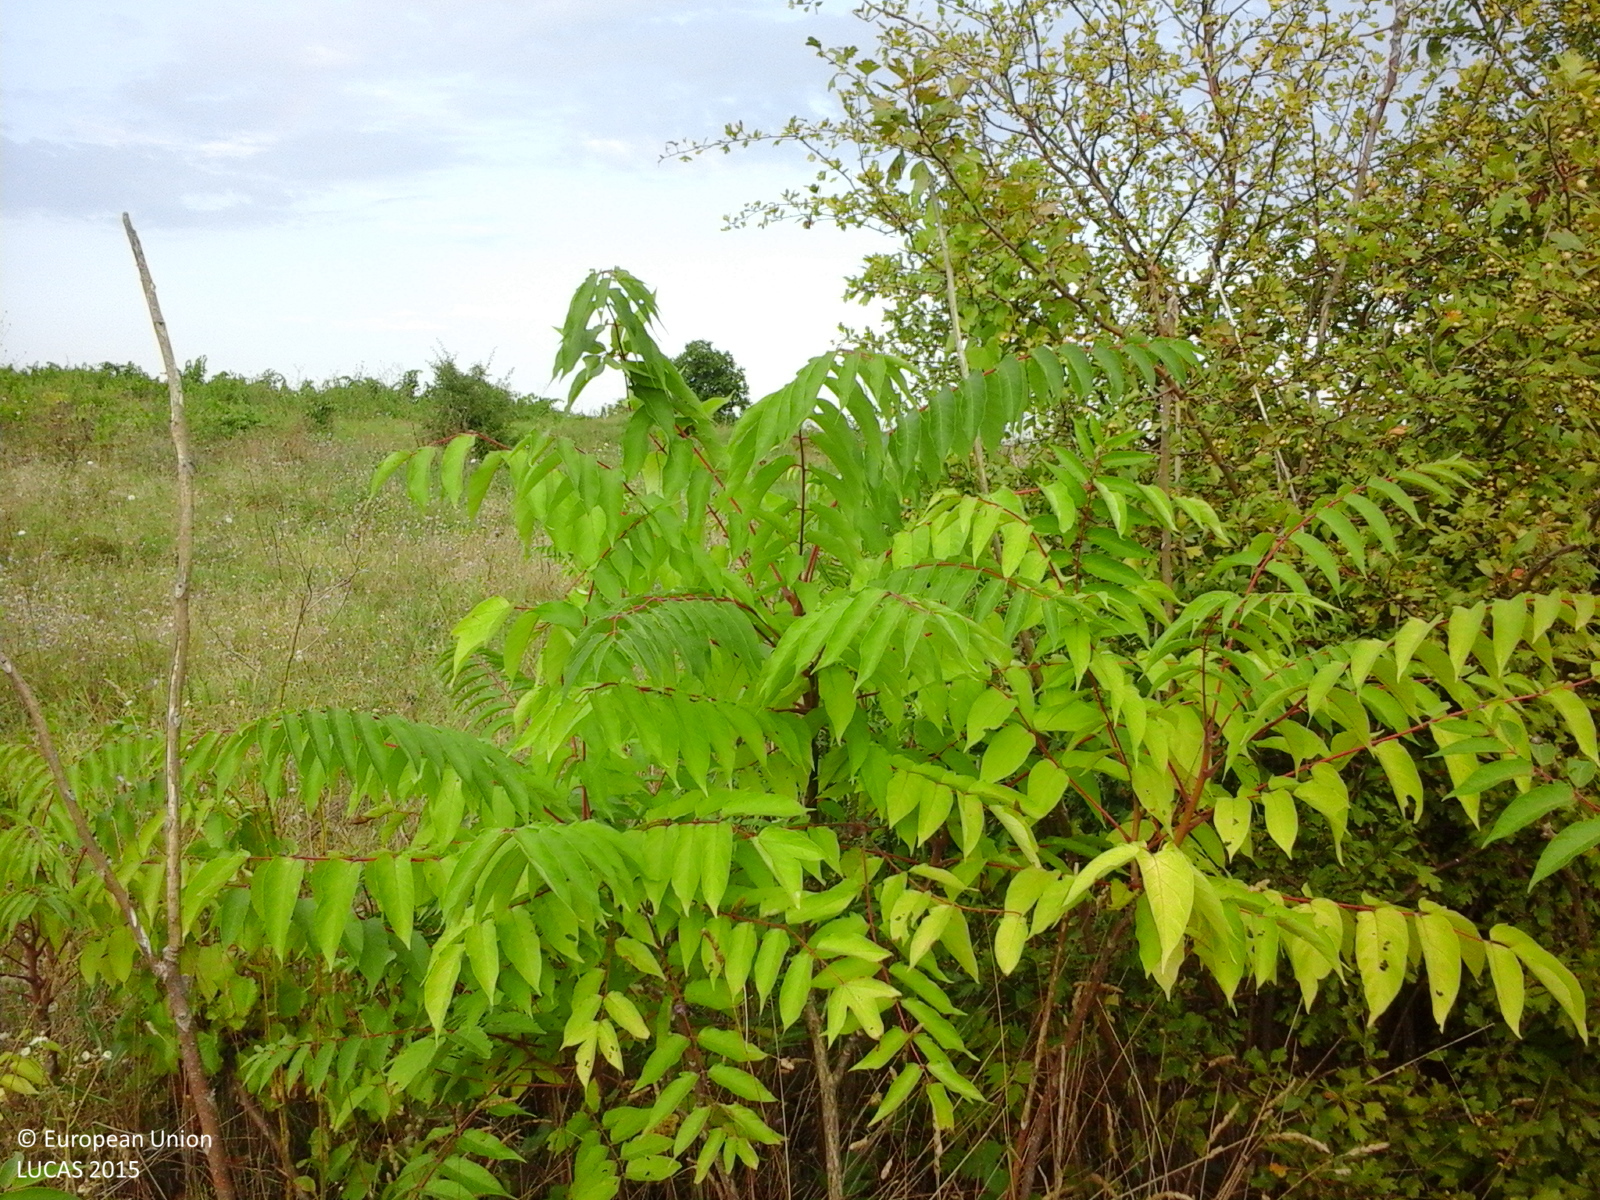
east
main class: Shrubland
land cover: Shrubland with sparse tree cover
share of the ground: > 75 %
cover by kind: shrubs 85 %, herbaceous plants 10 %, broadleaved forest trees 5 %
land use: Semi-natural and natural areas not in use
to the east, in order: Shrubland with sparse tree cover; Grassland without tree/shrub cover; Tracks; Vineyards; Tracks; Grassland with sparse tree/shrub cover; Vineyards
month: August
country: RO
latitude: 44.2715
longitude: 28.0081
